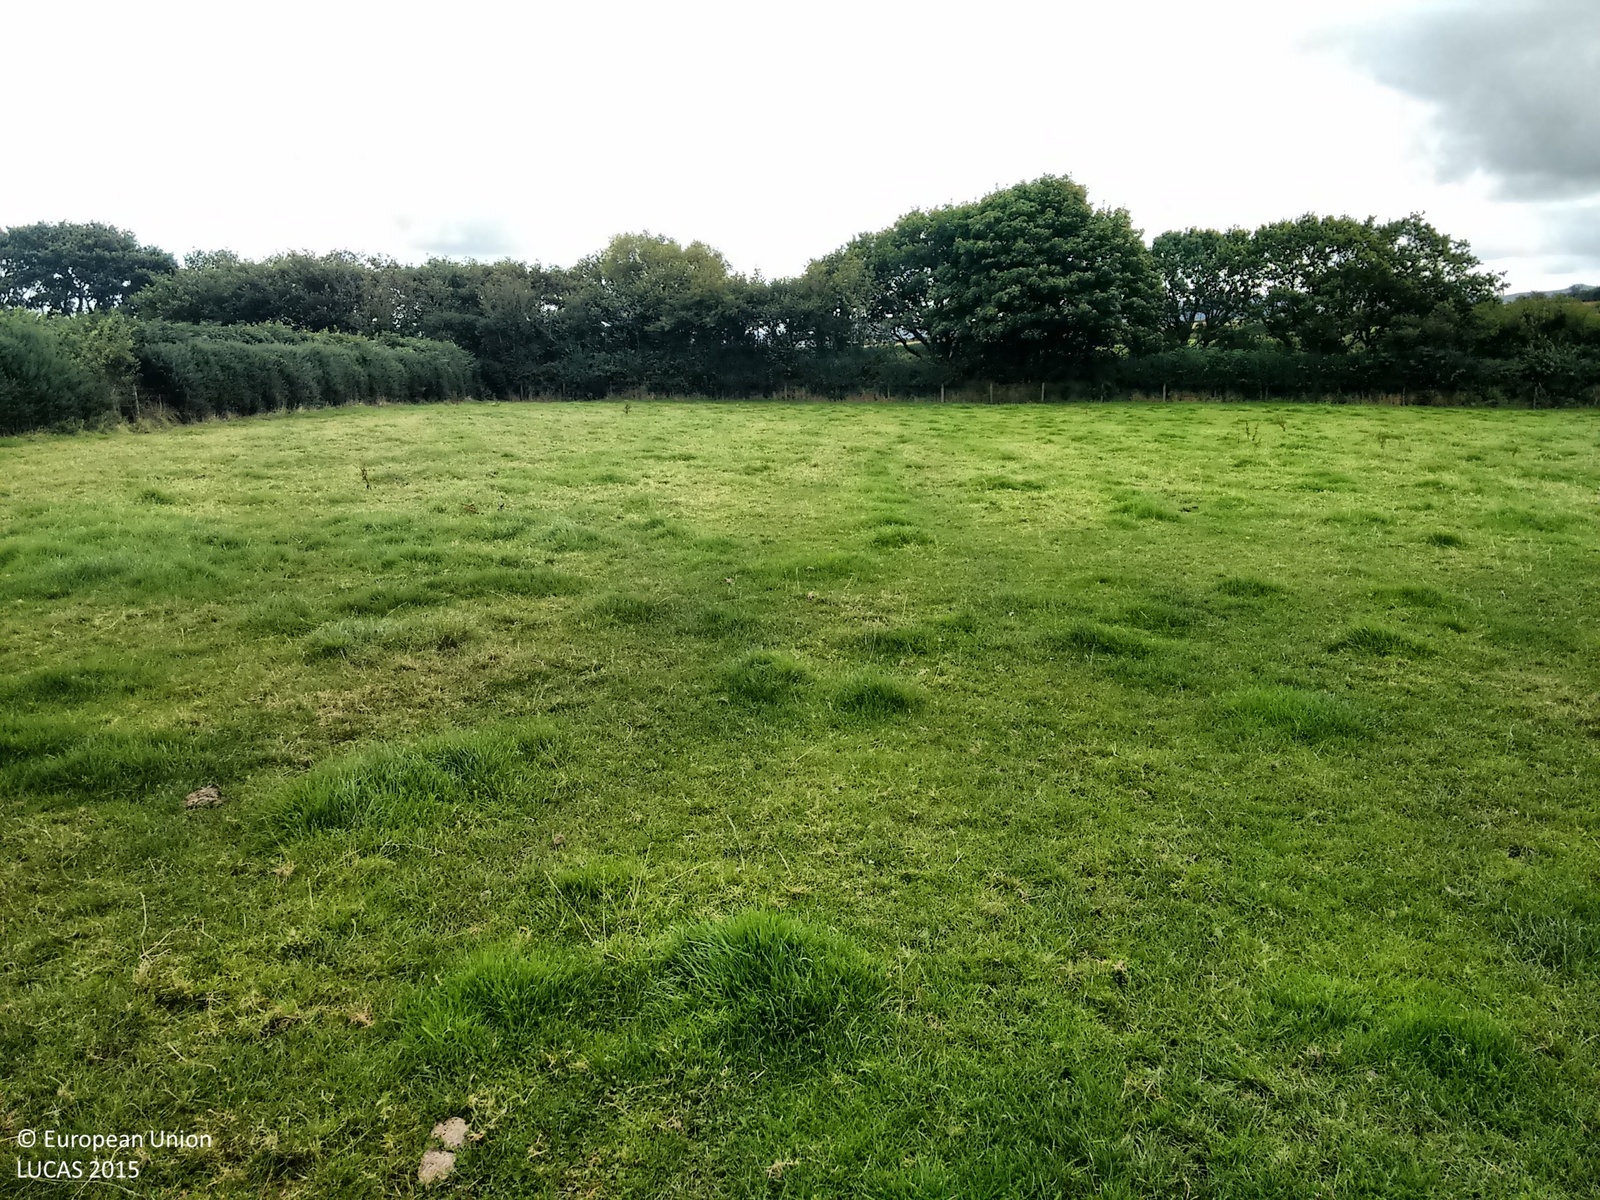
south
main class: Grassland
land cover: Grassland without tree/shrub cover
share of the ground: > 75 %
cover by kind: herbaceous plants 100 %
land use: Agriculture (excluding fallow land and kitchen gardens)
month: September
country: GB
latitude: 50.5925
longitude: -4.4411
